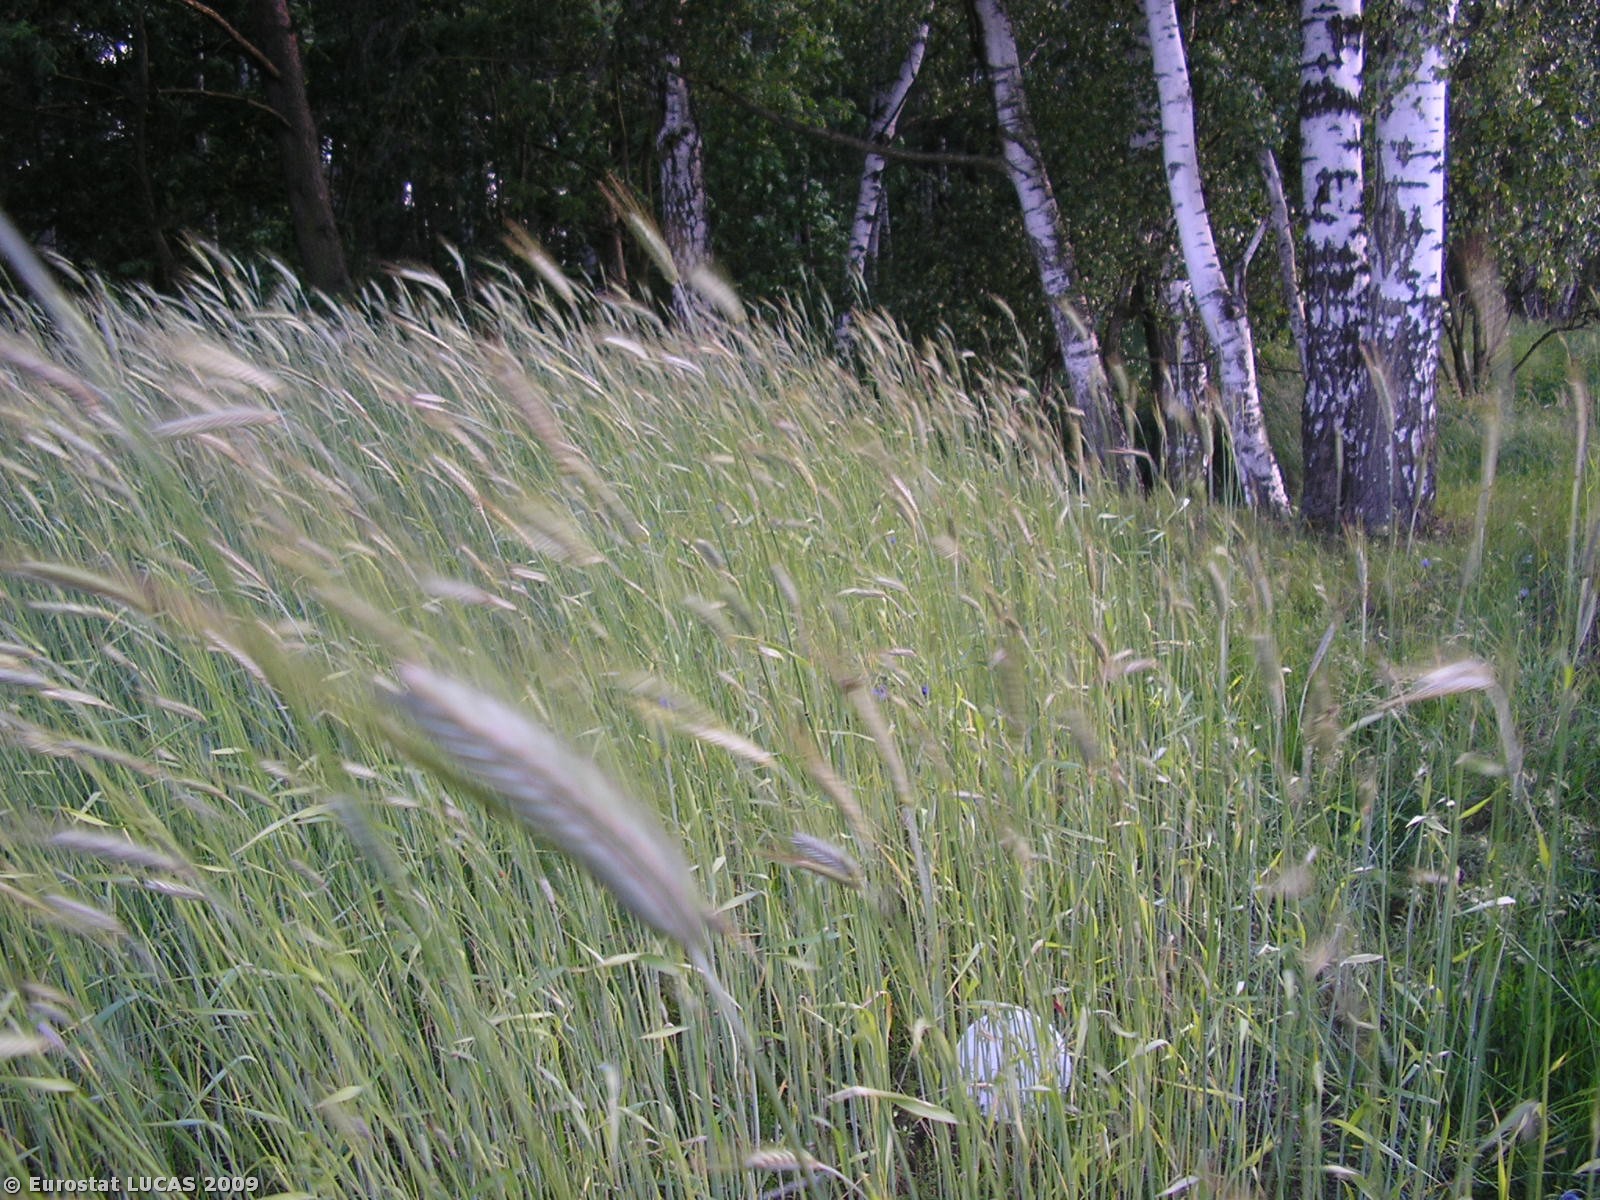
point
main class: Cropland
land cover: Rye
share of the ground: > 75 %
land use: Agriculture (excluding fallow land and kitchen gardens)
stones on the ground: < 10 %
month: June
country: PL
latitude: 51.1450
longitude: 18.3232
